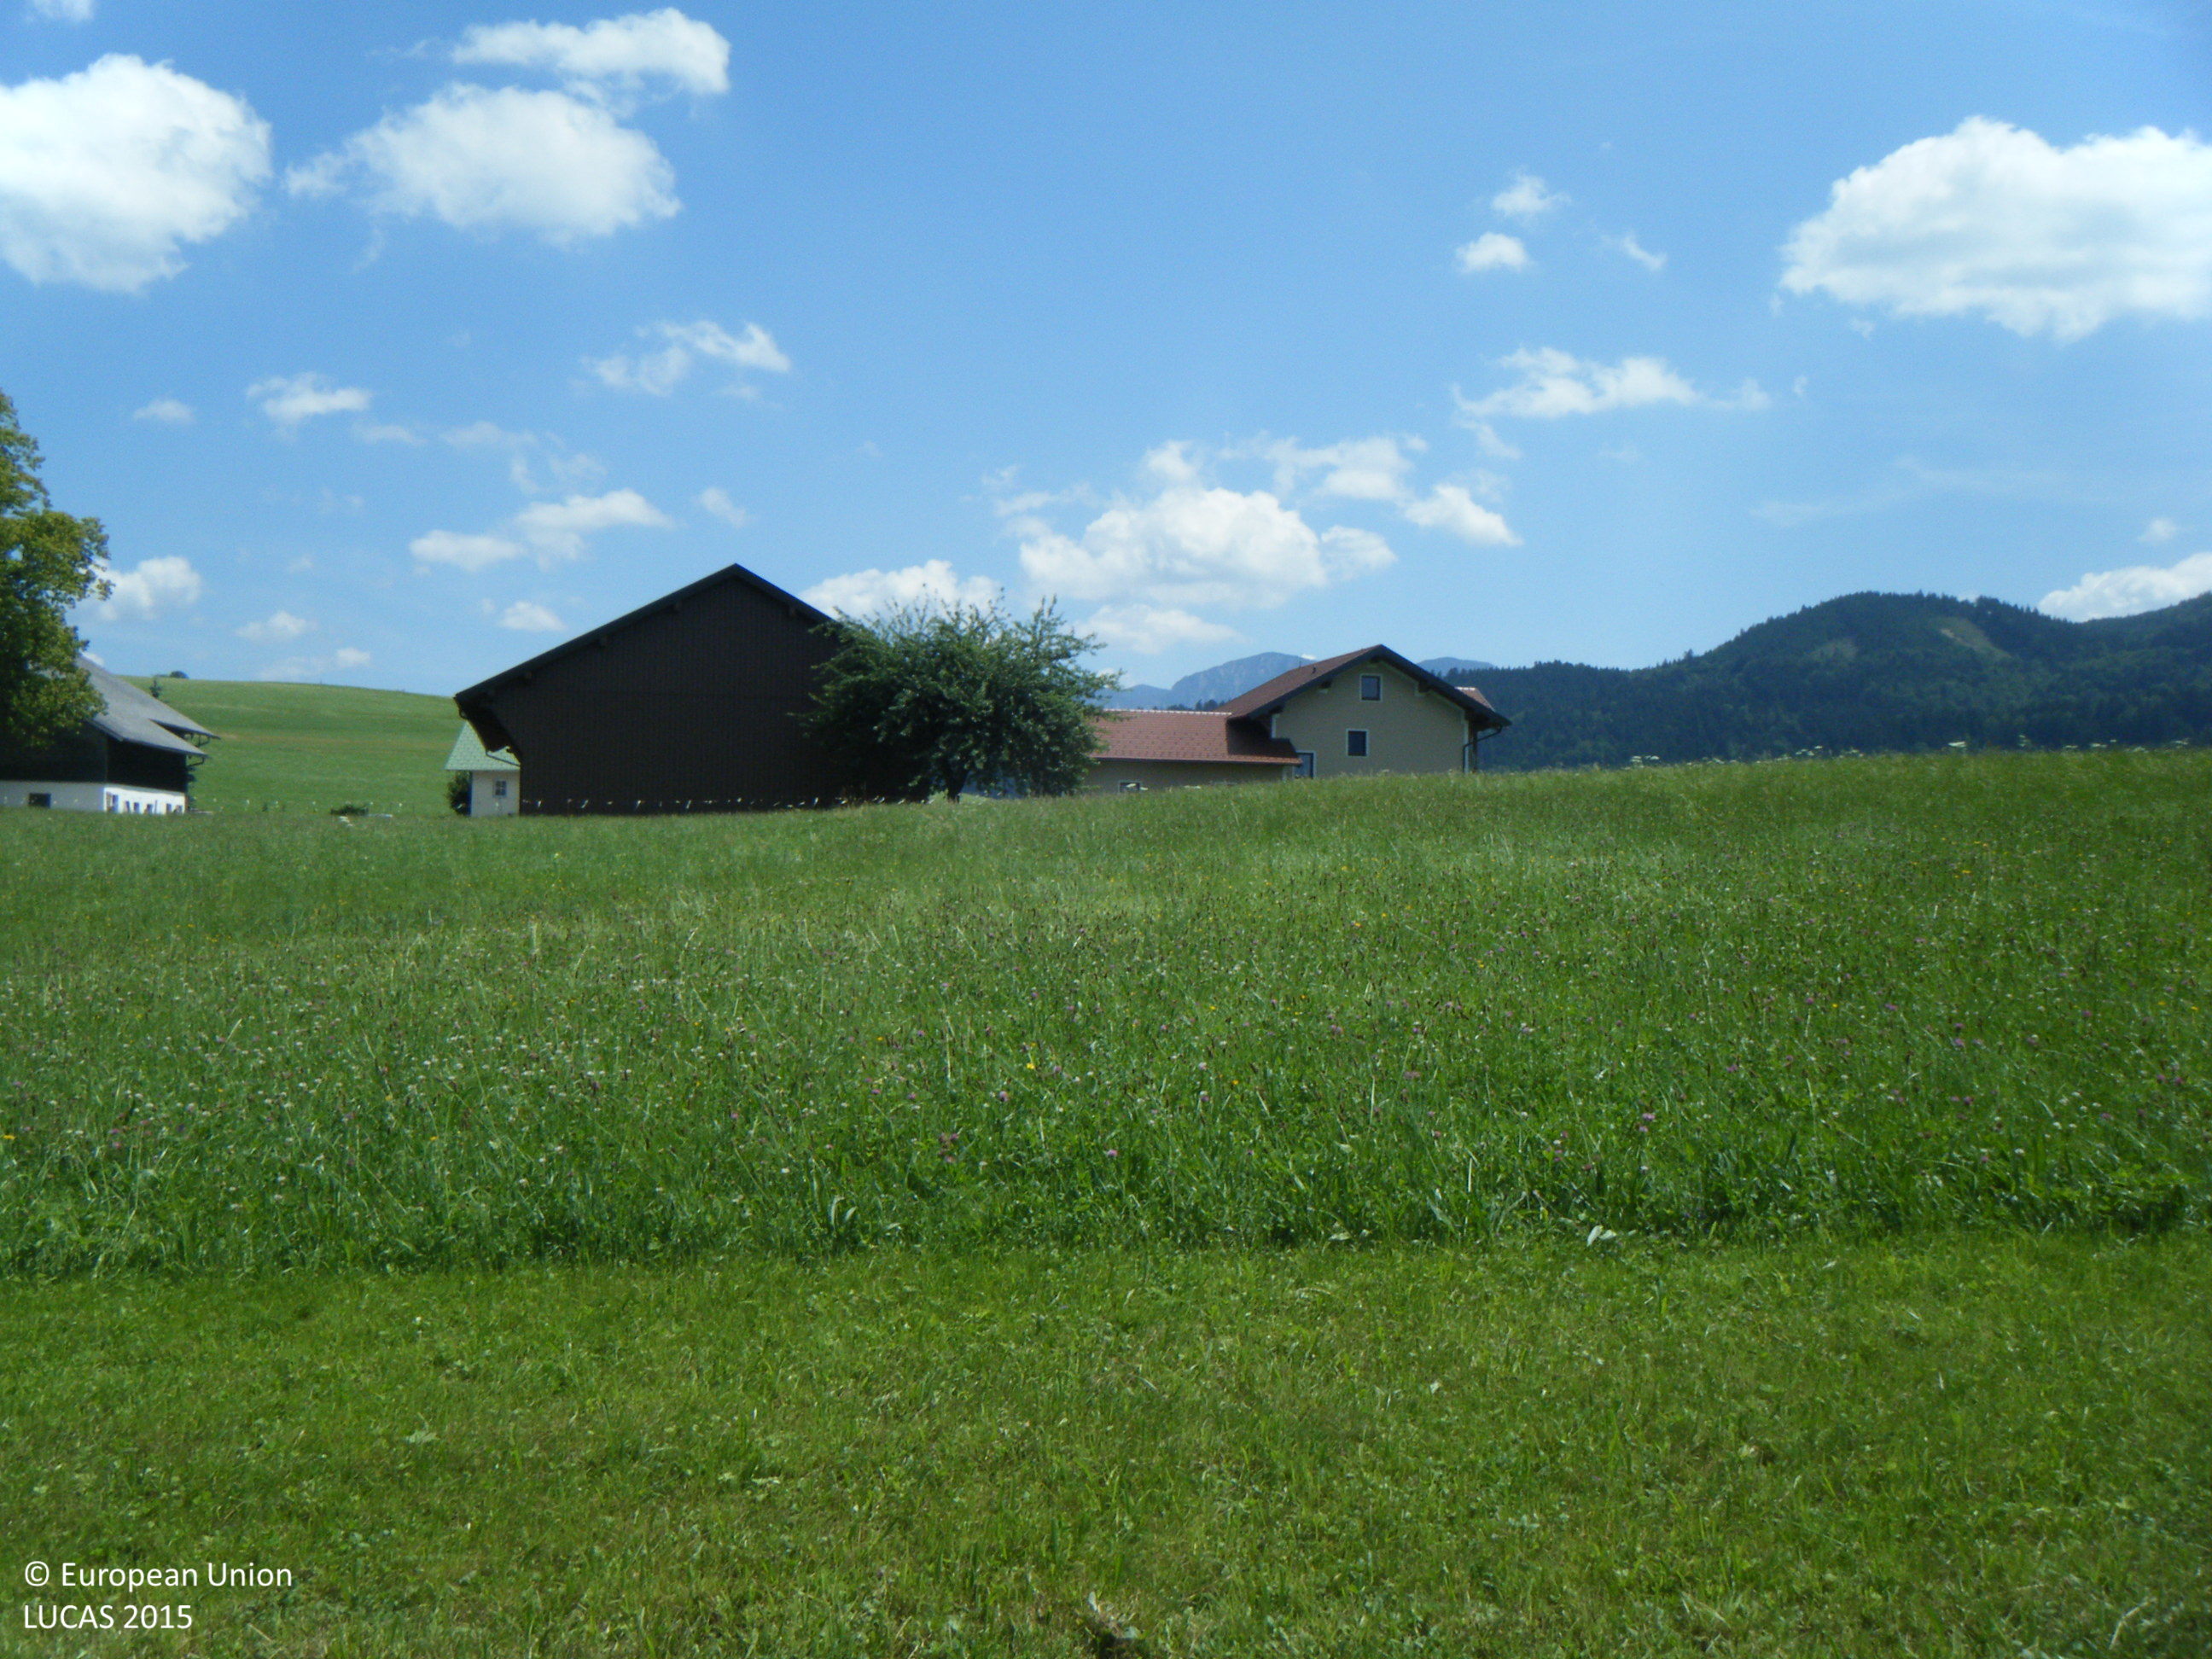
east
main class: Grassland
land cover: Grassland without tree/shrub cover
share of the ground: > 75 %
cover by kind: herbaceous plants 100 %
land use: Agriculture (excluding fallow land and kitchen gardens)
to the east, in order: Grassland without tree/shrub cover; Fences; Grassland without tree/shrub cover; Artificial constructions in urban areas; Grassland with sparse tree/shrub cover; Grassland without tree/shrub cover
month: July
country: AT
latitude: 47.8451
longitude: 13.4598
